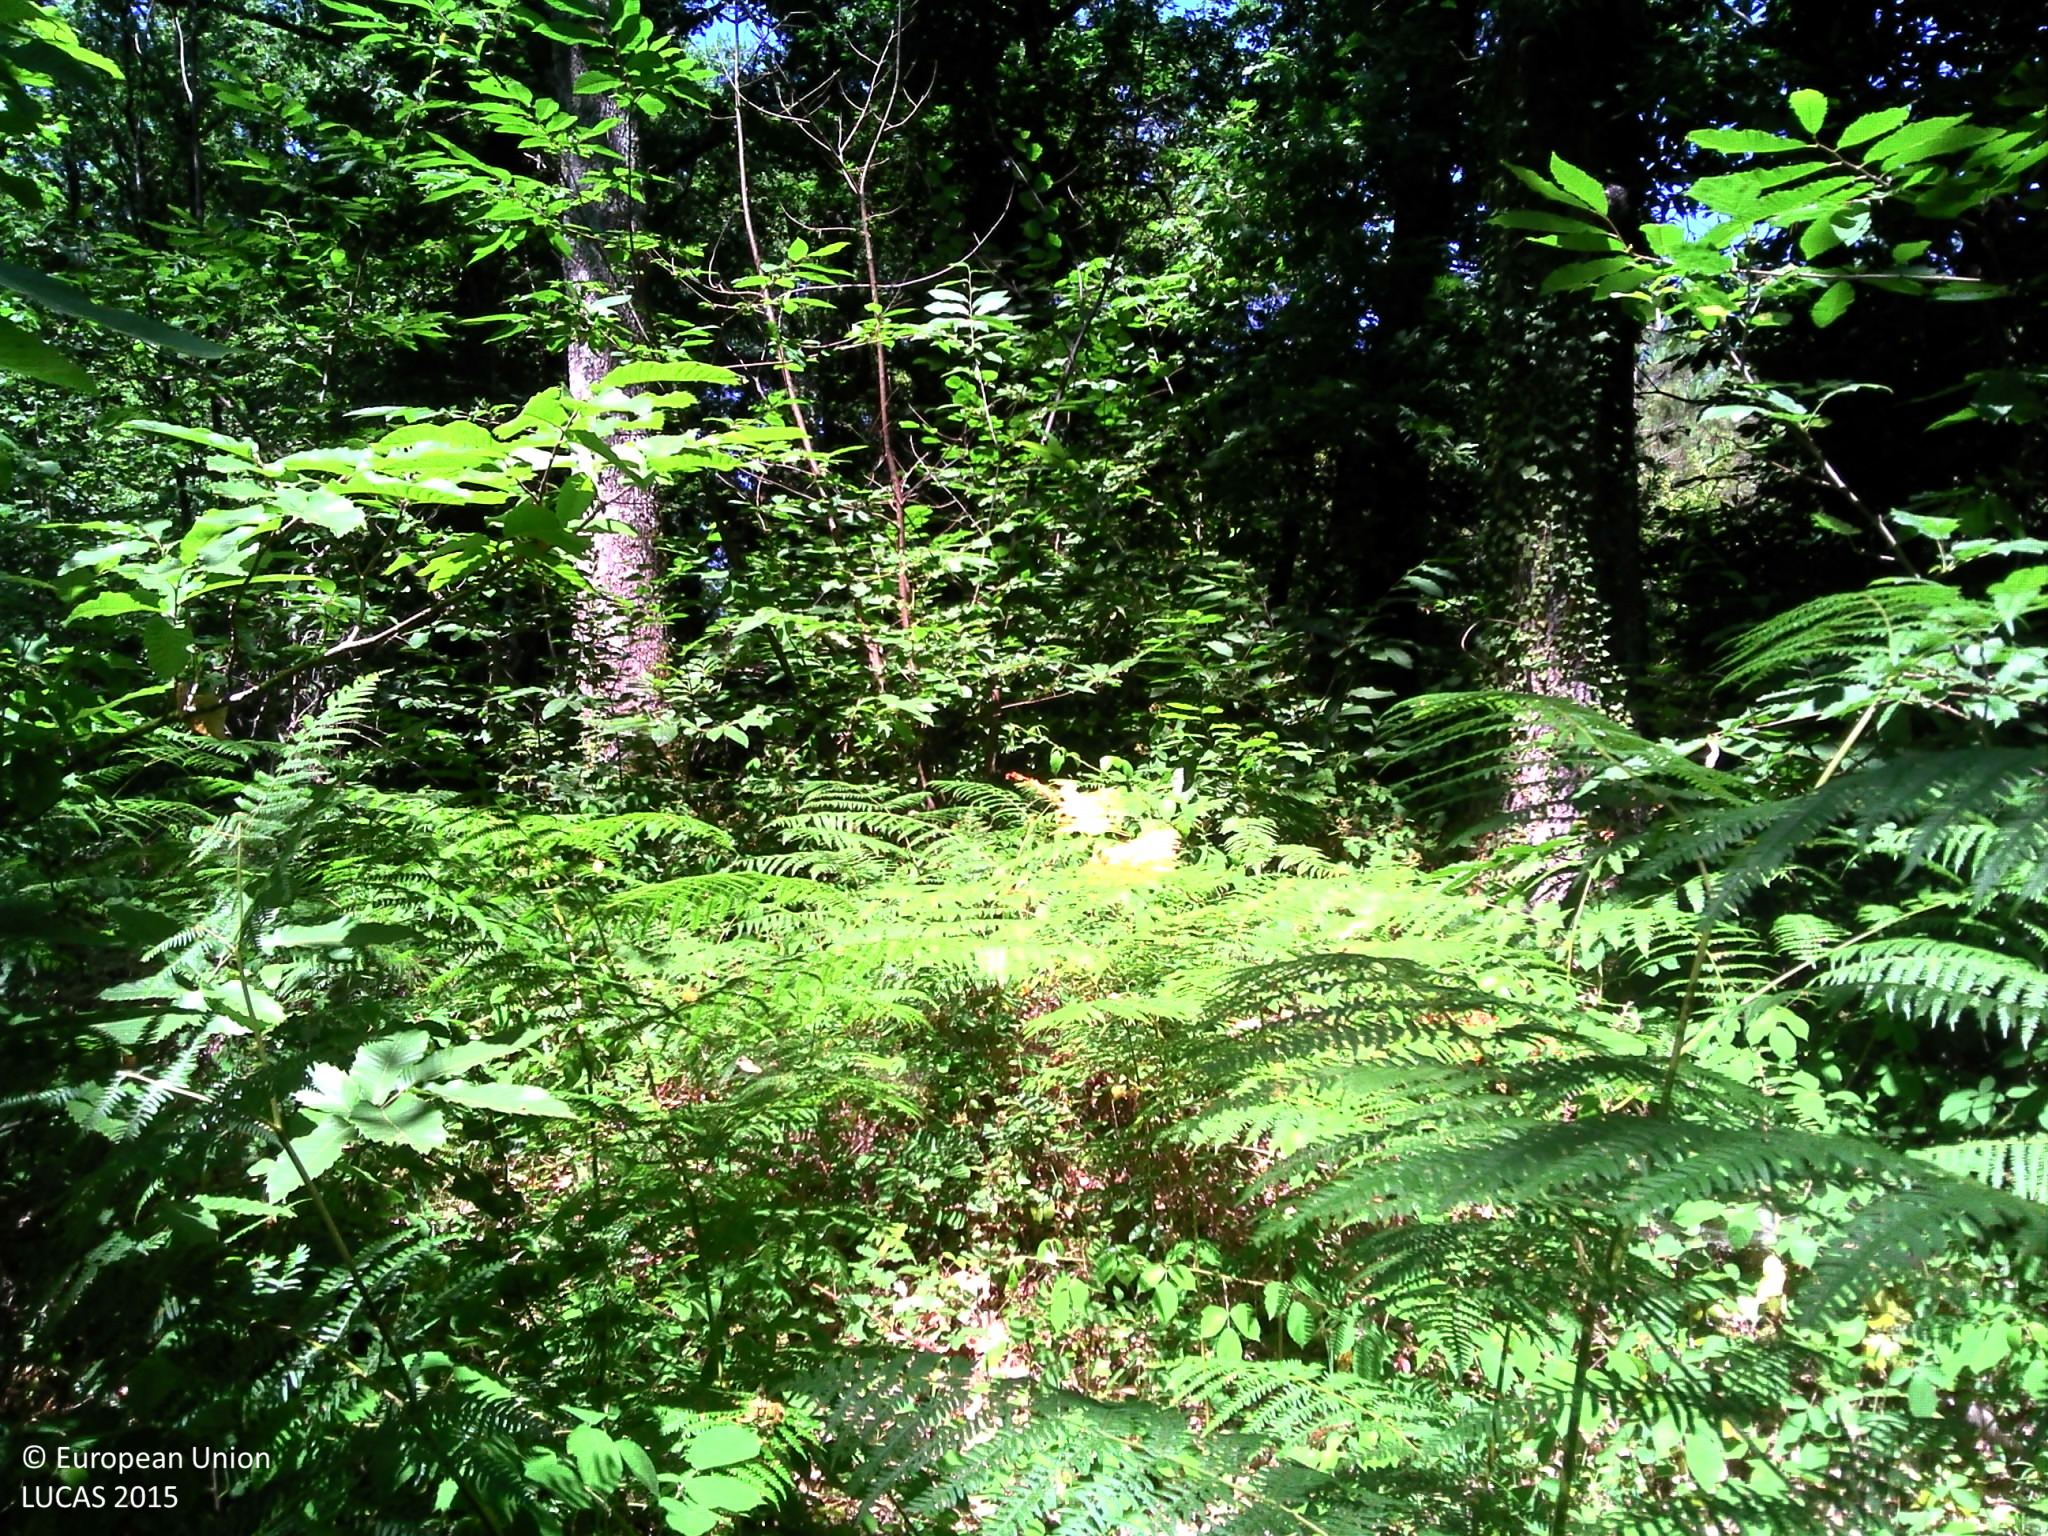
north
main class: Woodland
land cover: Broadleaved woodland
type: thermophilous deciduous forest
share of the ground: > 75 %
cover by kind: broadleaved forest trees 85 %, herbaceous plants 15 %
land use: Forestry
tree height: > 5 m
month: June
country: FR
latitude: 44.5637
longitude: 0.8660
